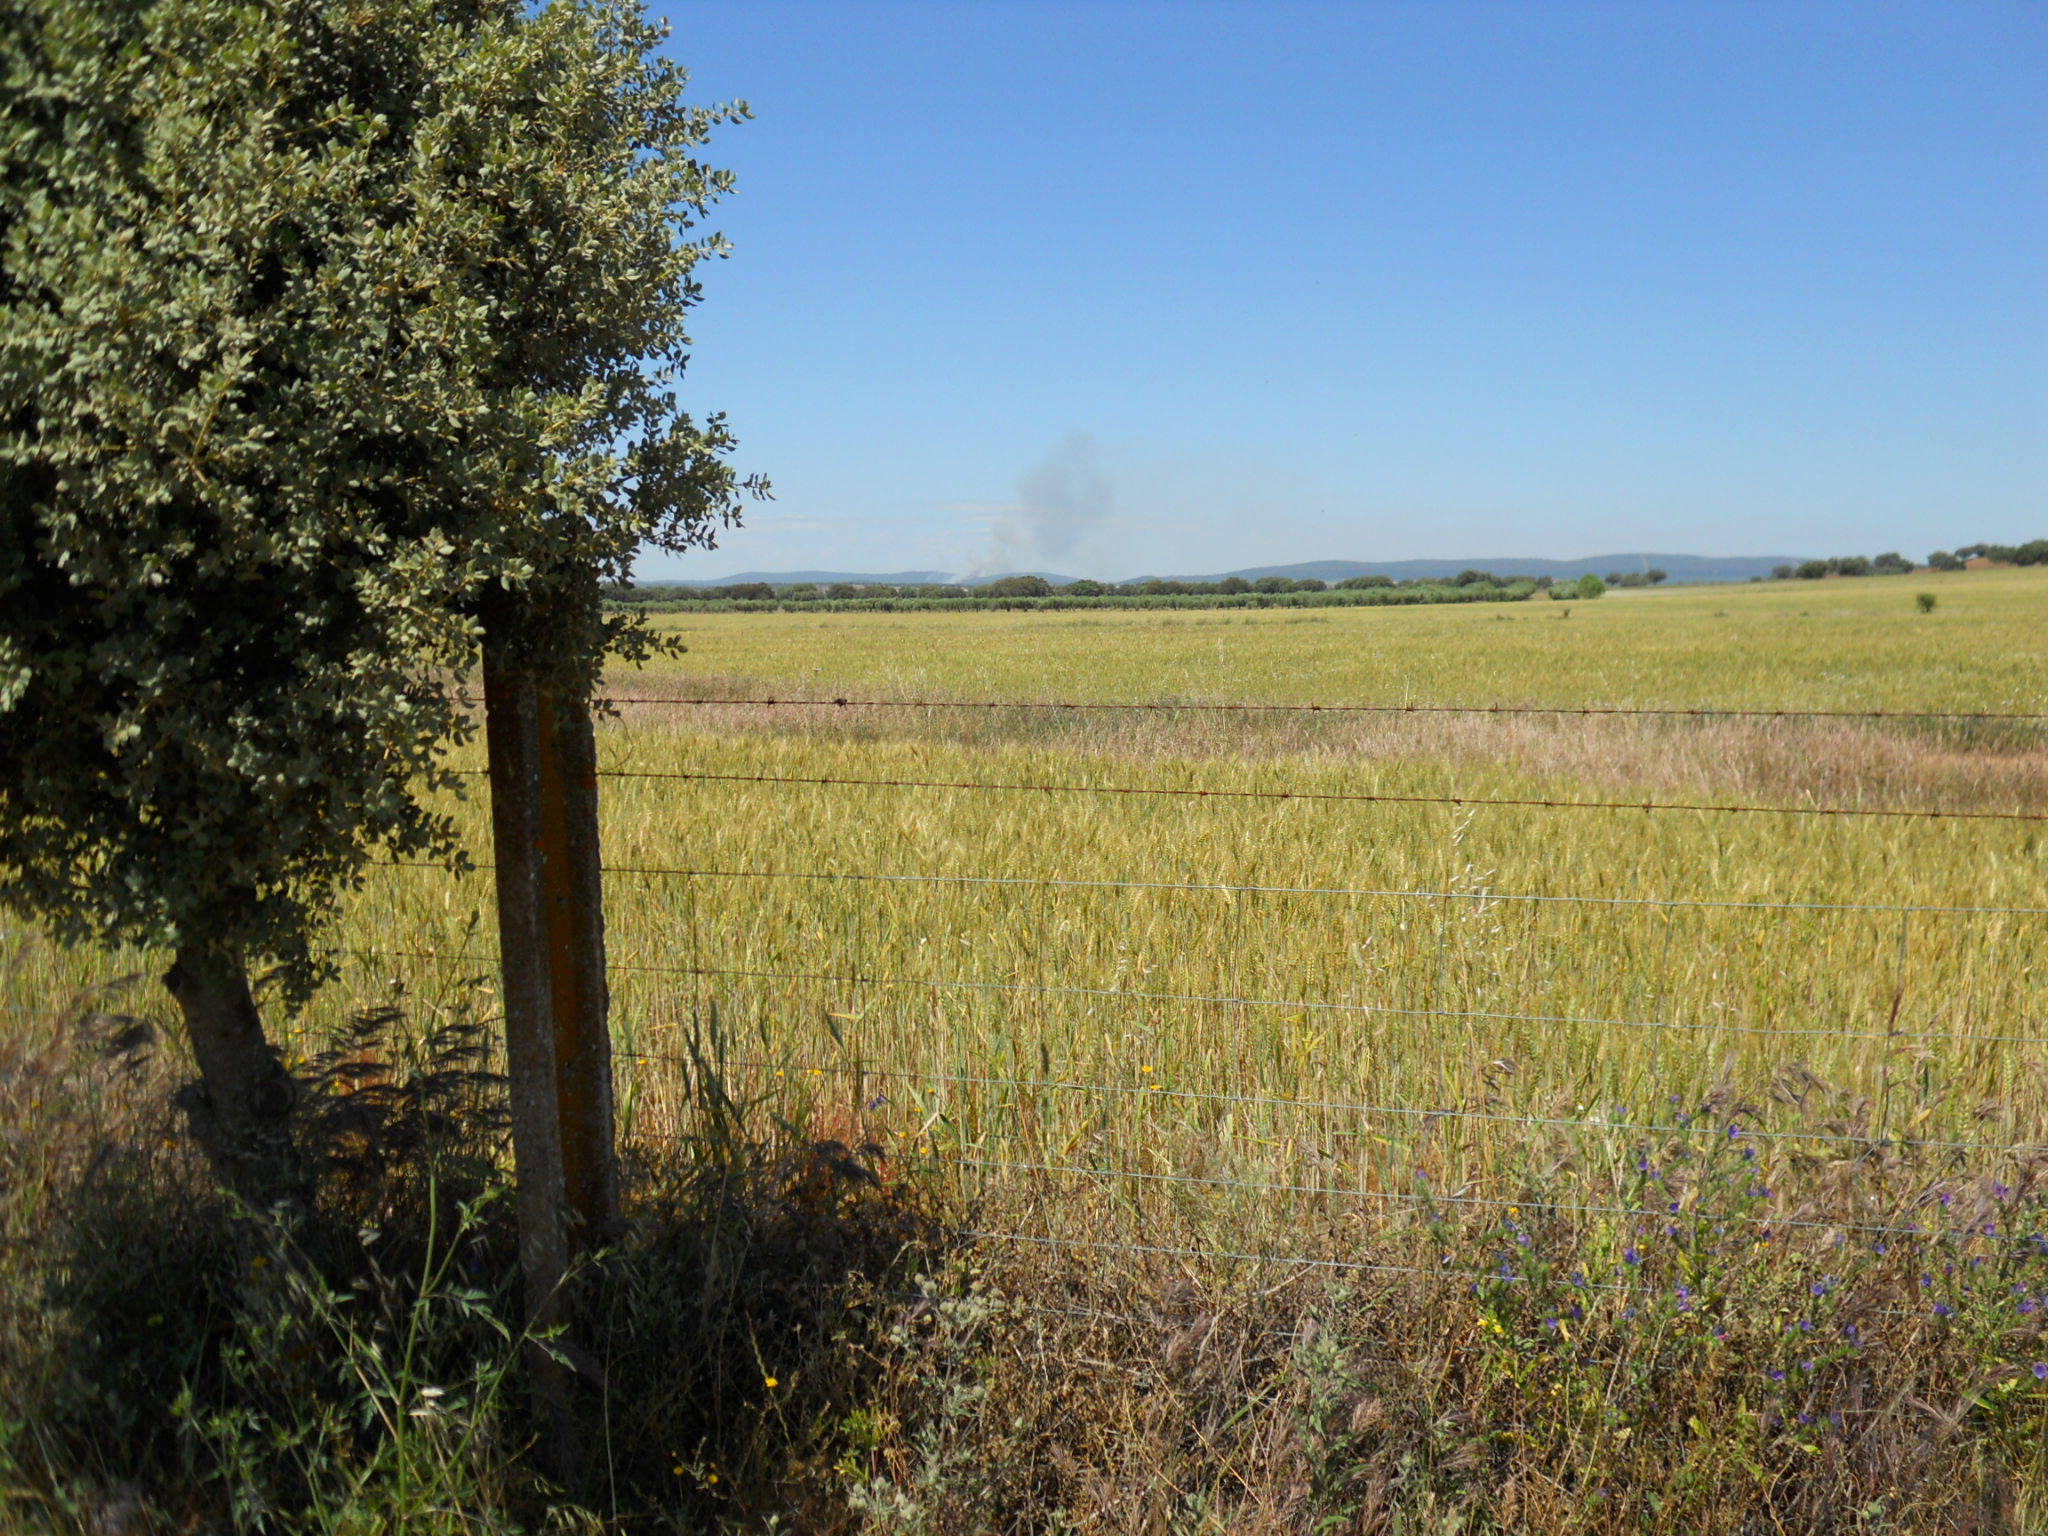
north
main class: Cropland
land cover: Olive groves
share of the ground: 10 - 25 %
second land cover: Other bare soil
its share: > 75 %
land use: Agriculture (excluding fallow land and kitchen gardens)
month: May
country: ES
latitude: 39.0312
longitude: -6.5717
